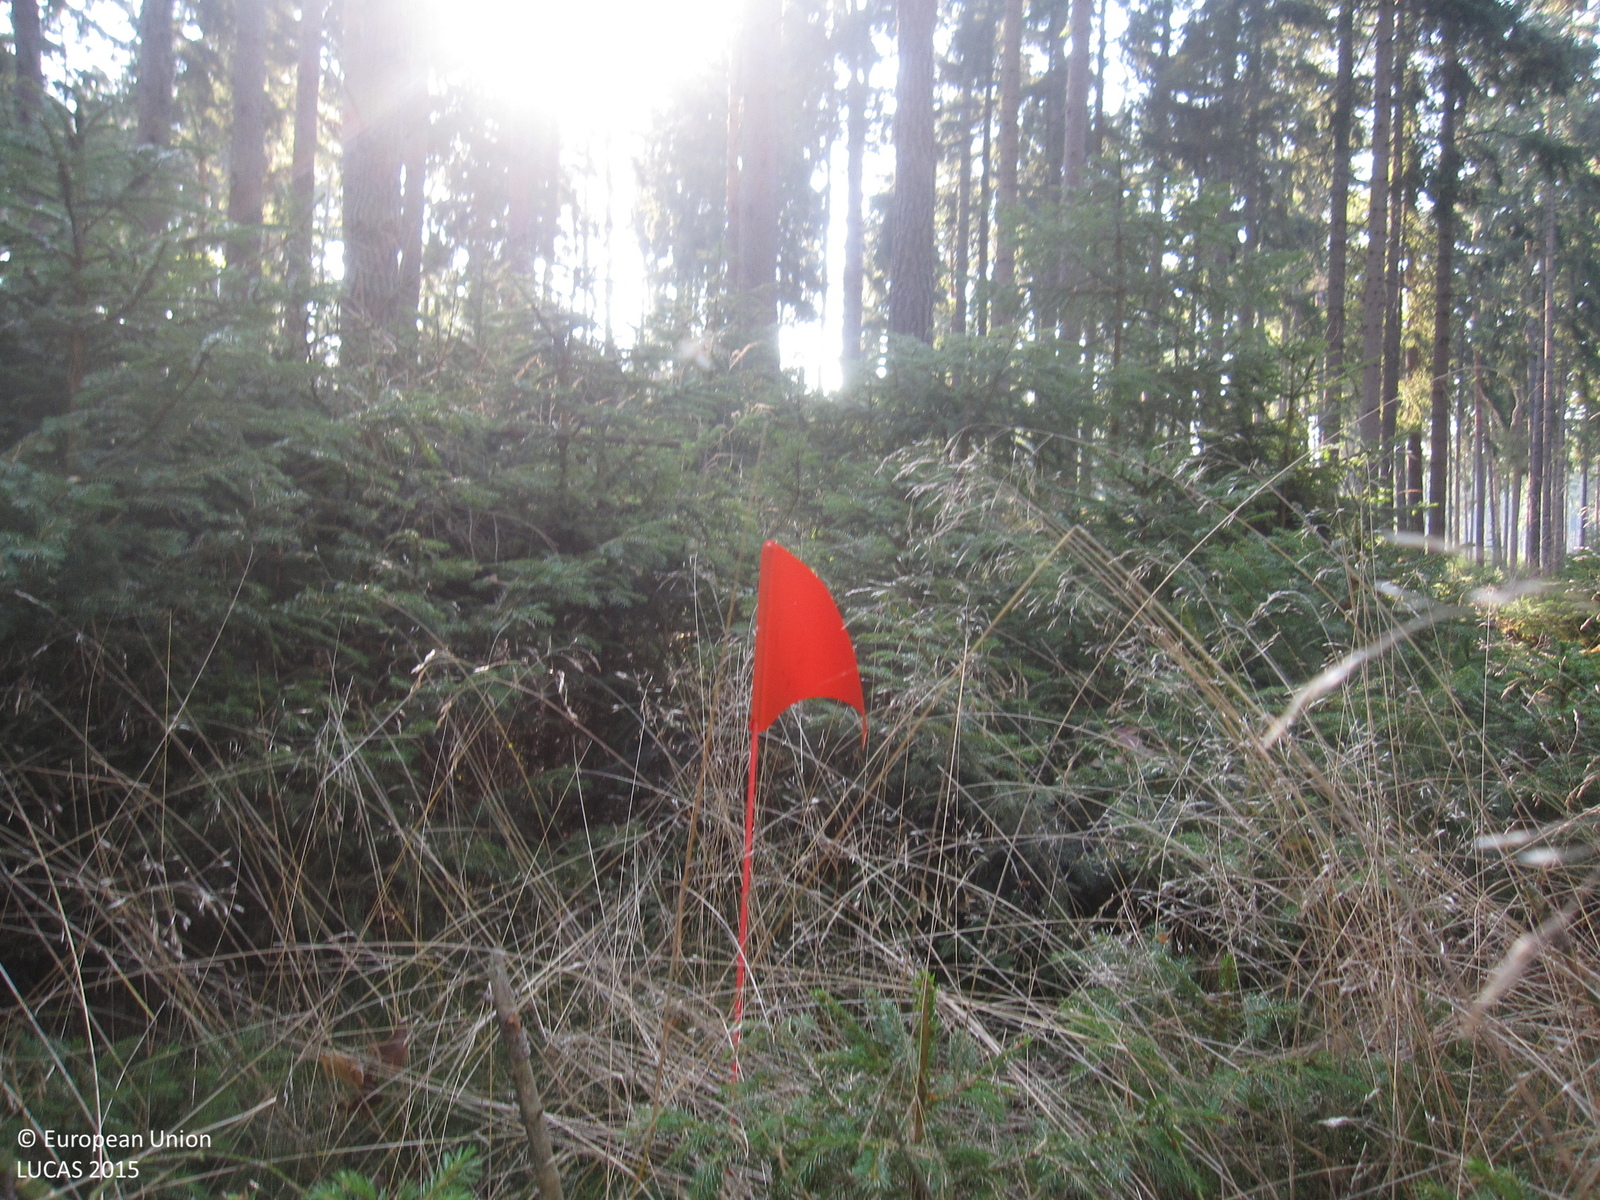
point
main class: Woodland
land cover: Spruce dominated coniferous woodland
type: hemiboreal forest and nemoral coniferous forest and mixed broadleaved-coniferous forest
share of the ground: > 75 %
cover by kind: coniferous forest trees 75 %, lichens and mosses 15 %, herbaceous plants 10 %
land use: Forestry
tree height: > 5 m
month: August
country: DE
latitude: 50.6335
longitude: 12.0497
